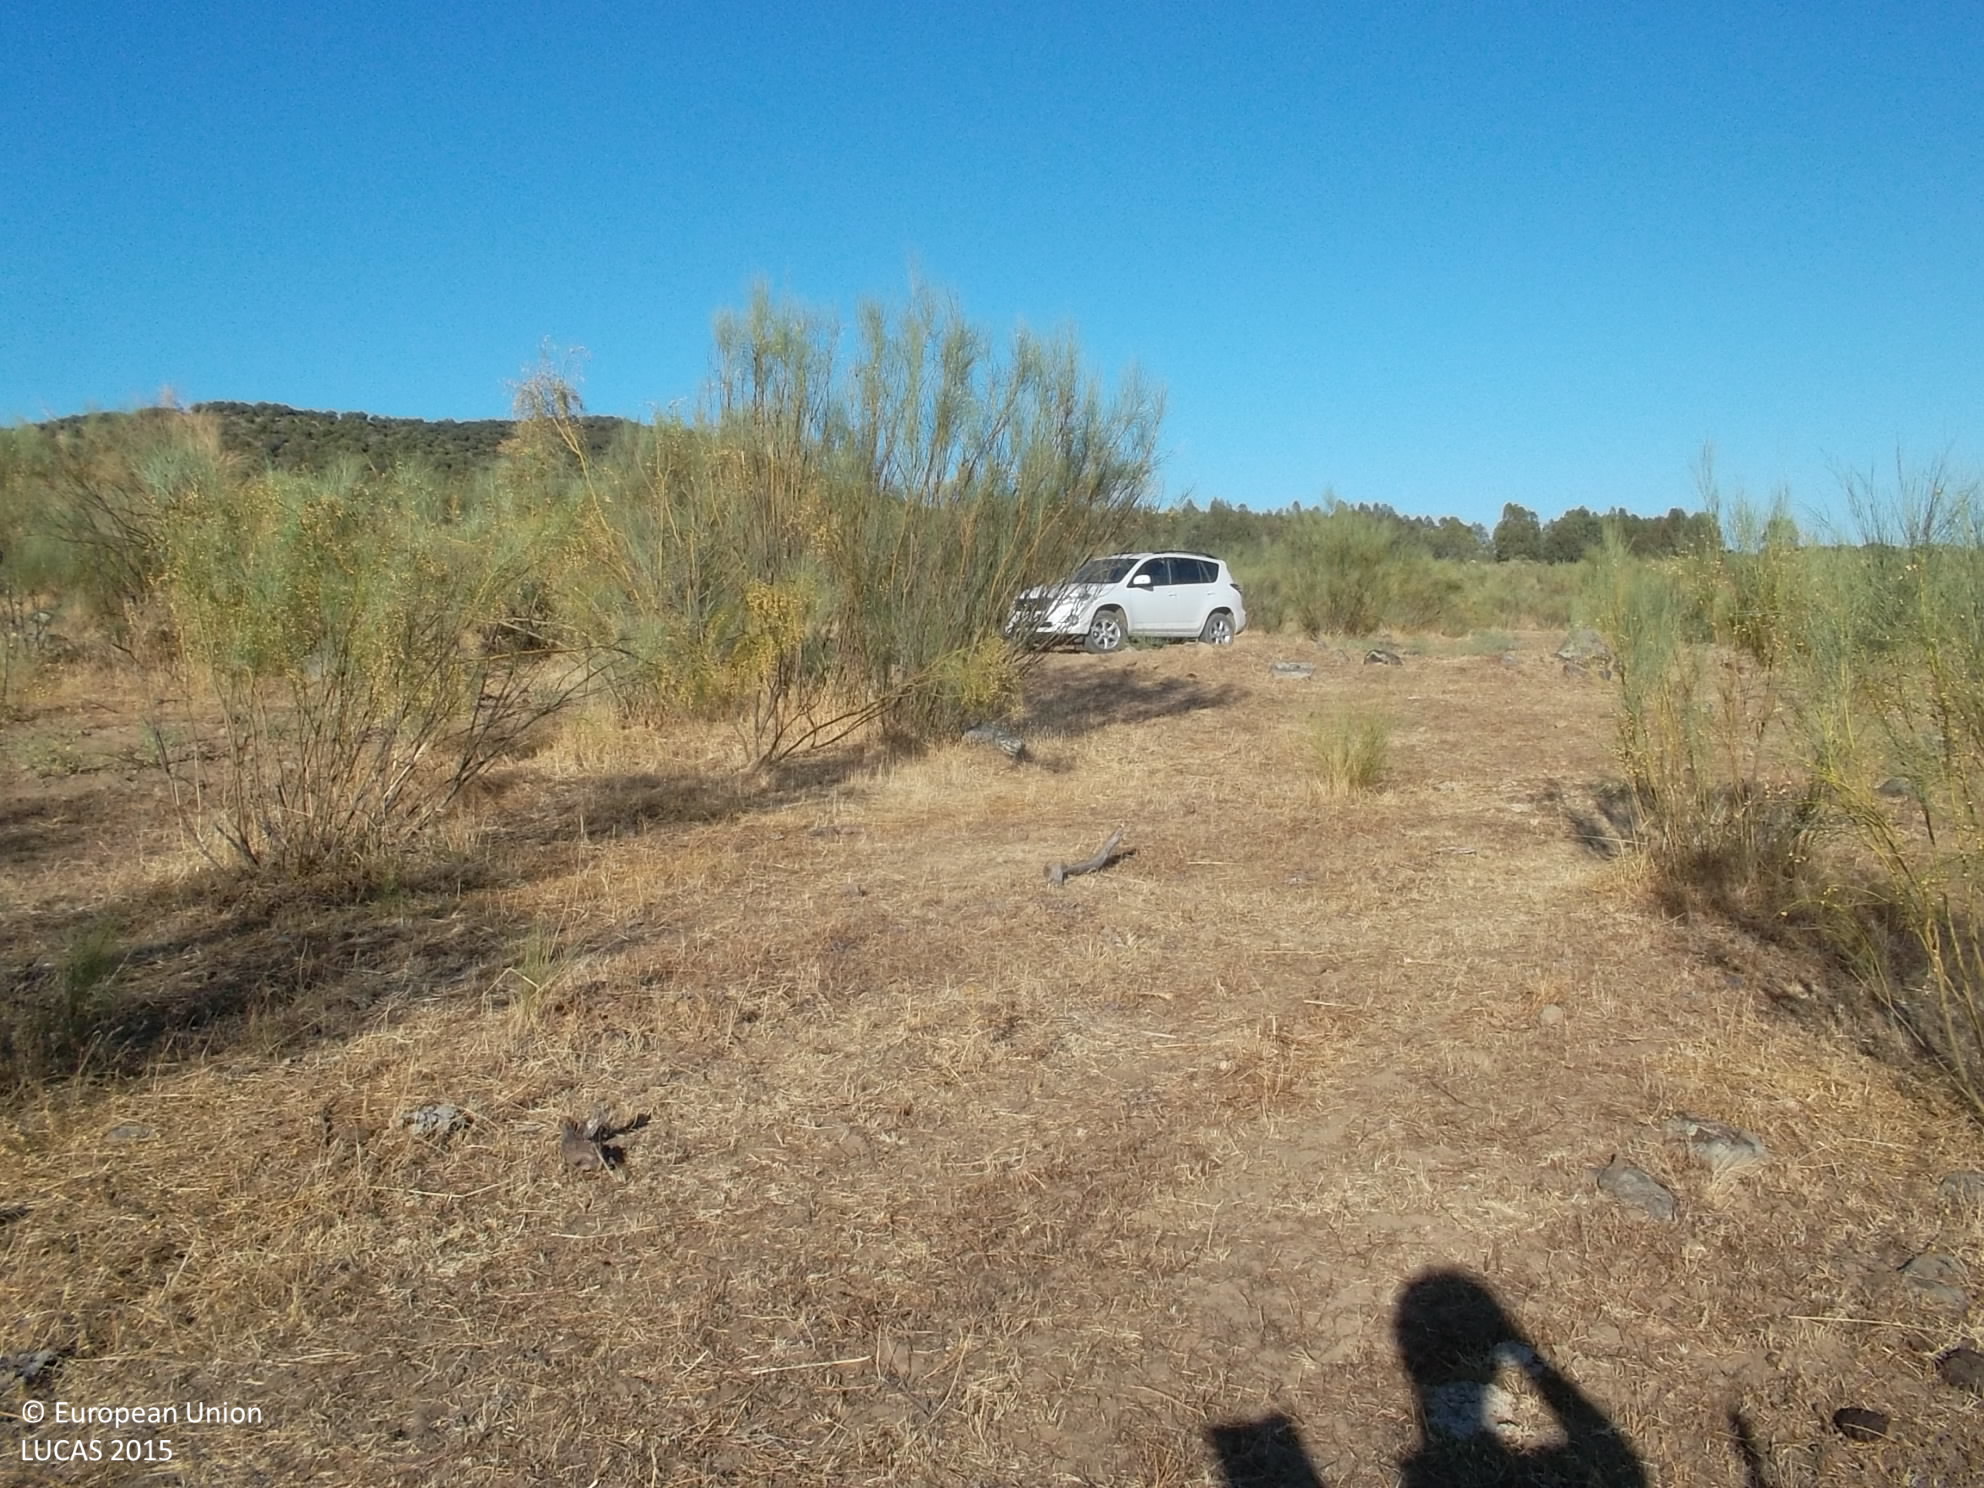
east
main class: Shrubland
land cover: Shrubland with sparse tree cover
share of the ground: > 75 %
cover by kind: herbaceous plants 75 %, shrubs 20 %, broadleaved forest trees 5 %
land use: Agriculture (excluding fallow land and kitchen gardens)
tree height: < 5 m
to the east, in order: Shrubland with sparse tree cover; Ditches and canals; Shrubland with sparse tree cover; Fences; Shrubland with sparse tree cover
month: August
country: ES
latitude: 38.3663
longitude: -6.6844
